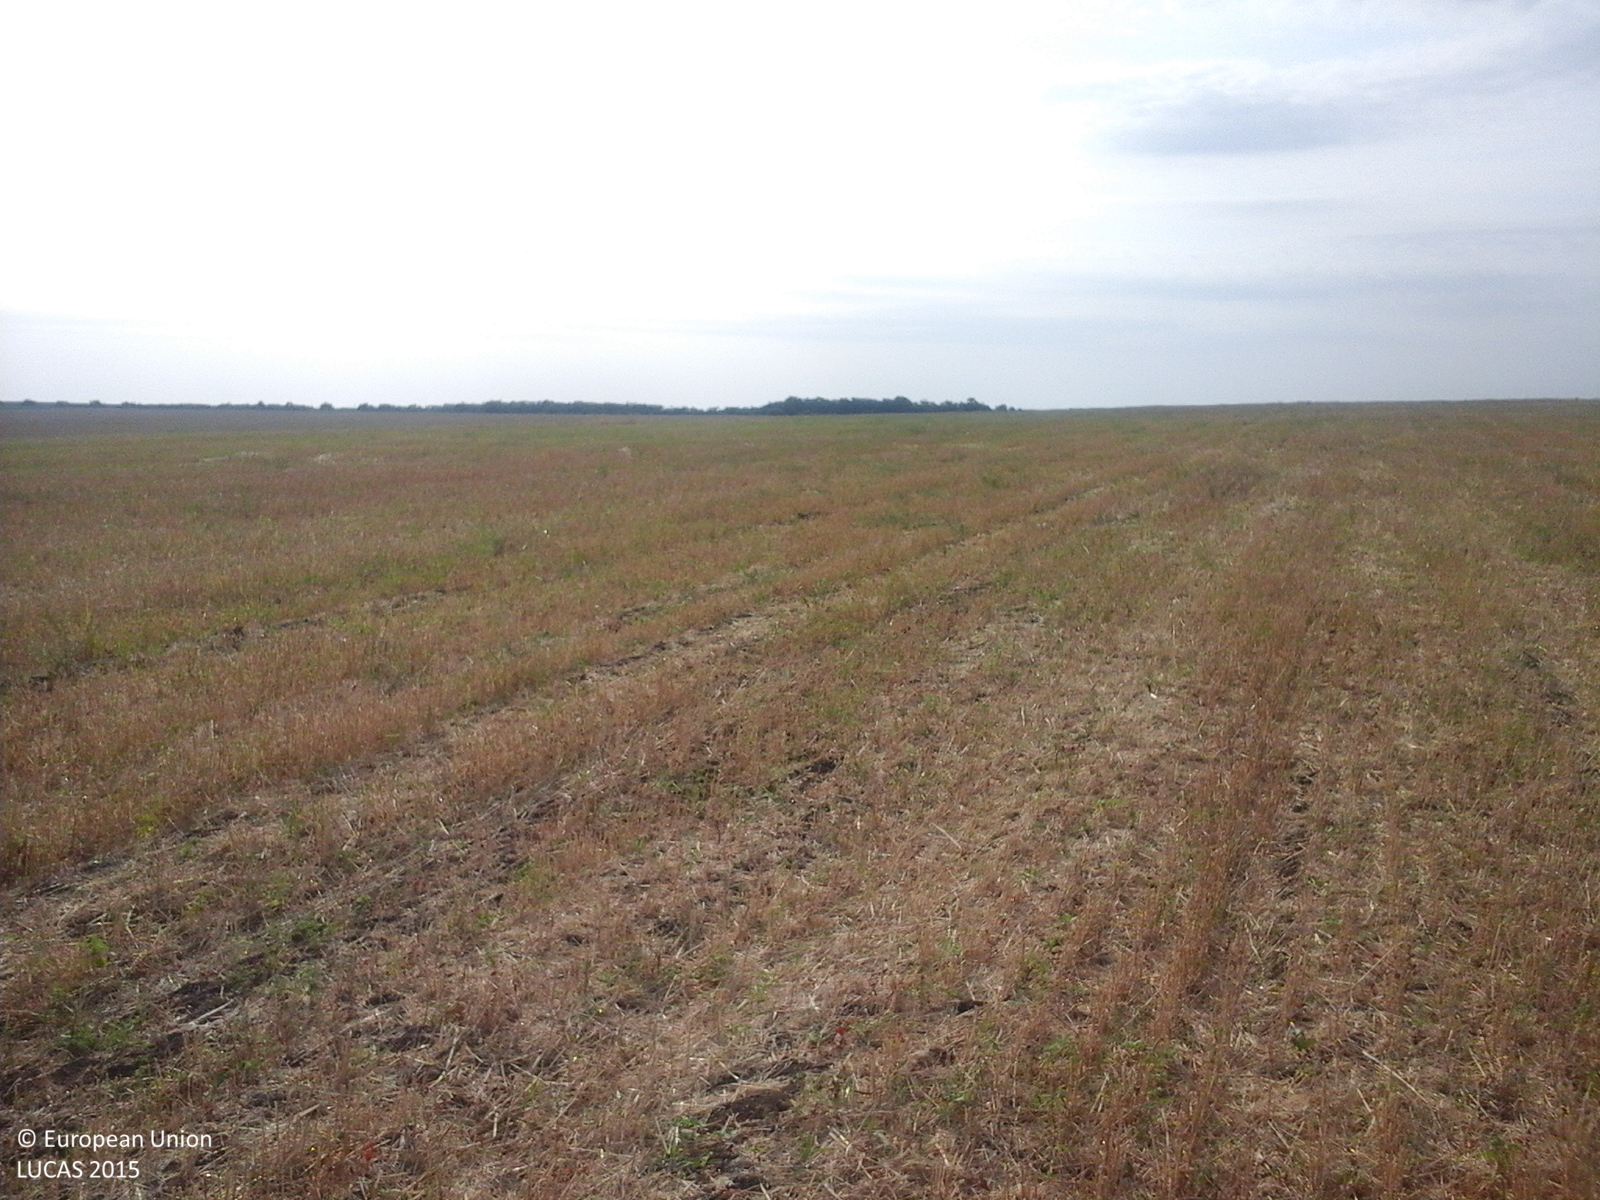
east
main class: Cropland
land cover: Barley
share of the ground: 50 - 75 %
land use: Agriculture (excluding fallow land and kitchen gardens)
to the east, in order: Barley
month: August
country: RO
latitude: 44.0316
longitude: 27.9049
